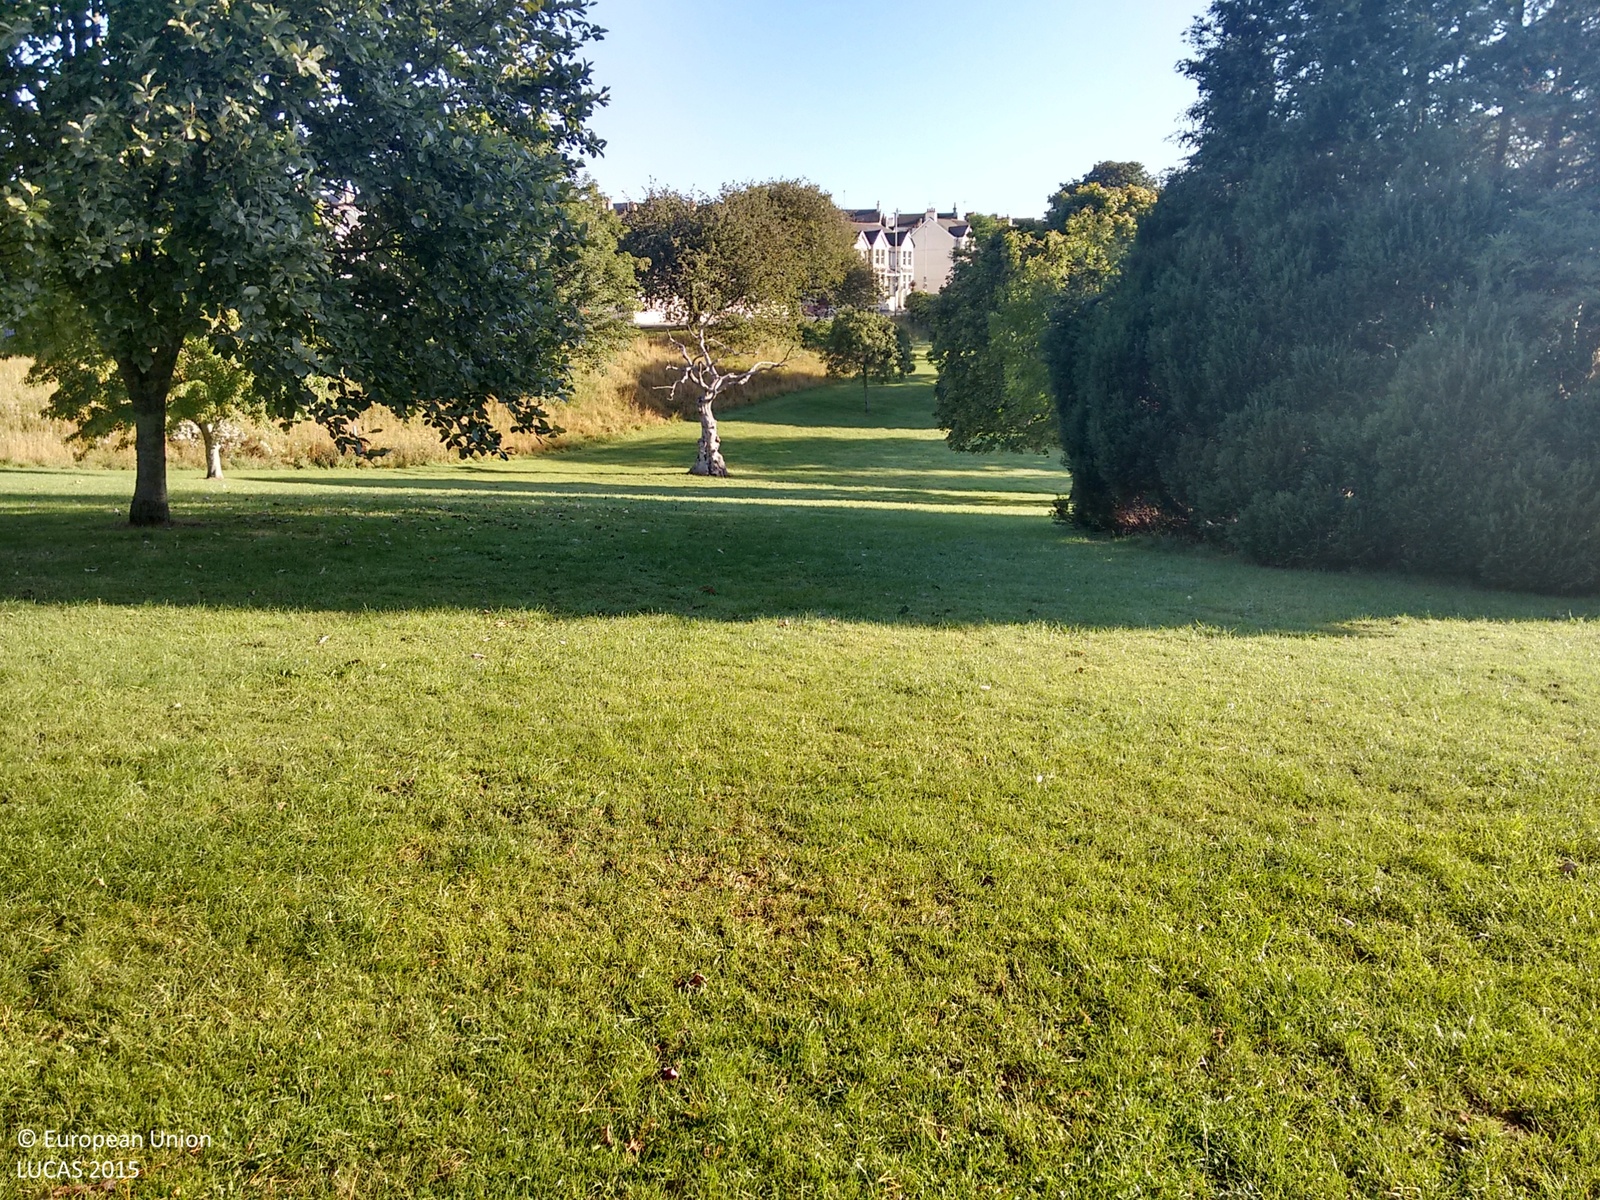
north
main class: Grassland
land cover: Grassland with sparse tree/shrub cover
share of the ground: > 75 %
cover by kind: herbaceous plants 95 %, broadleaved forest trees 5 %
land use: Amenities, museums, leisure
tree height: > 5 m
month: August
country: GB
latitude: 50.3918
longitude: -4.1487
